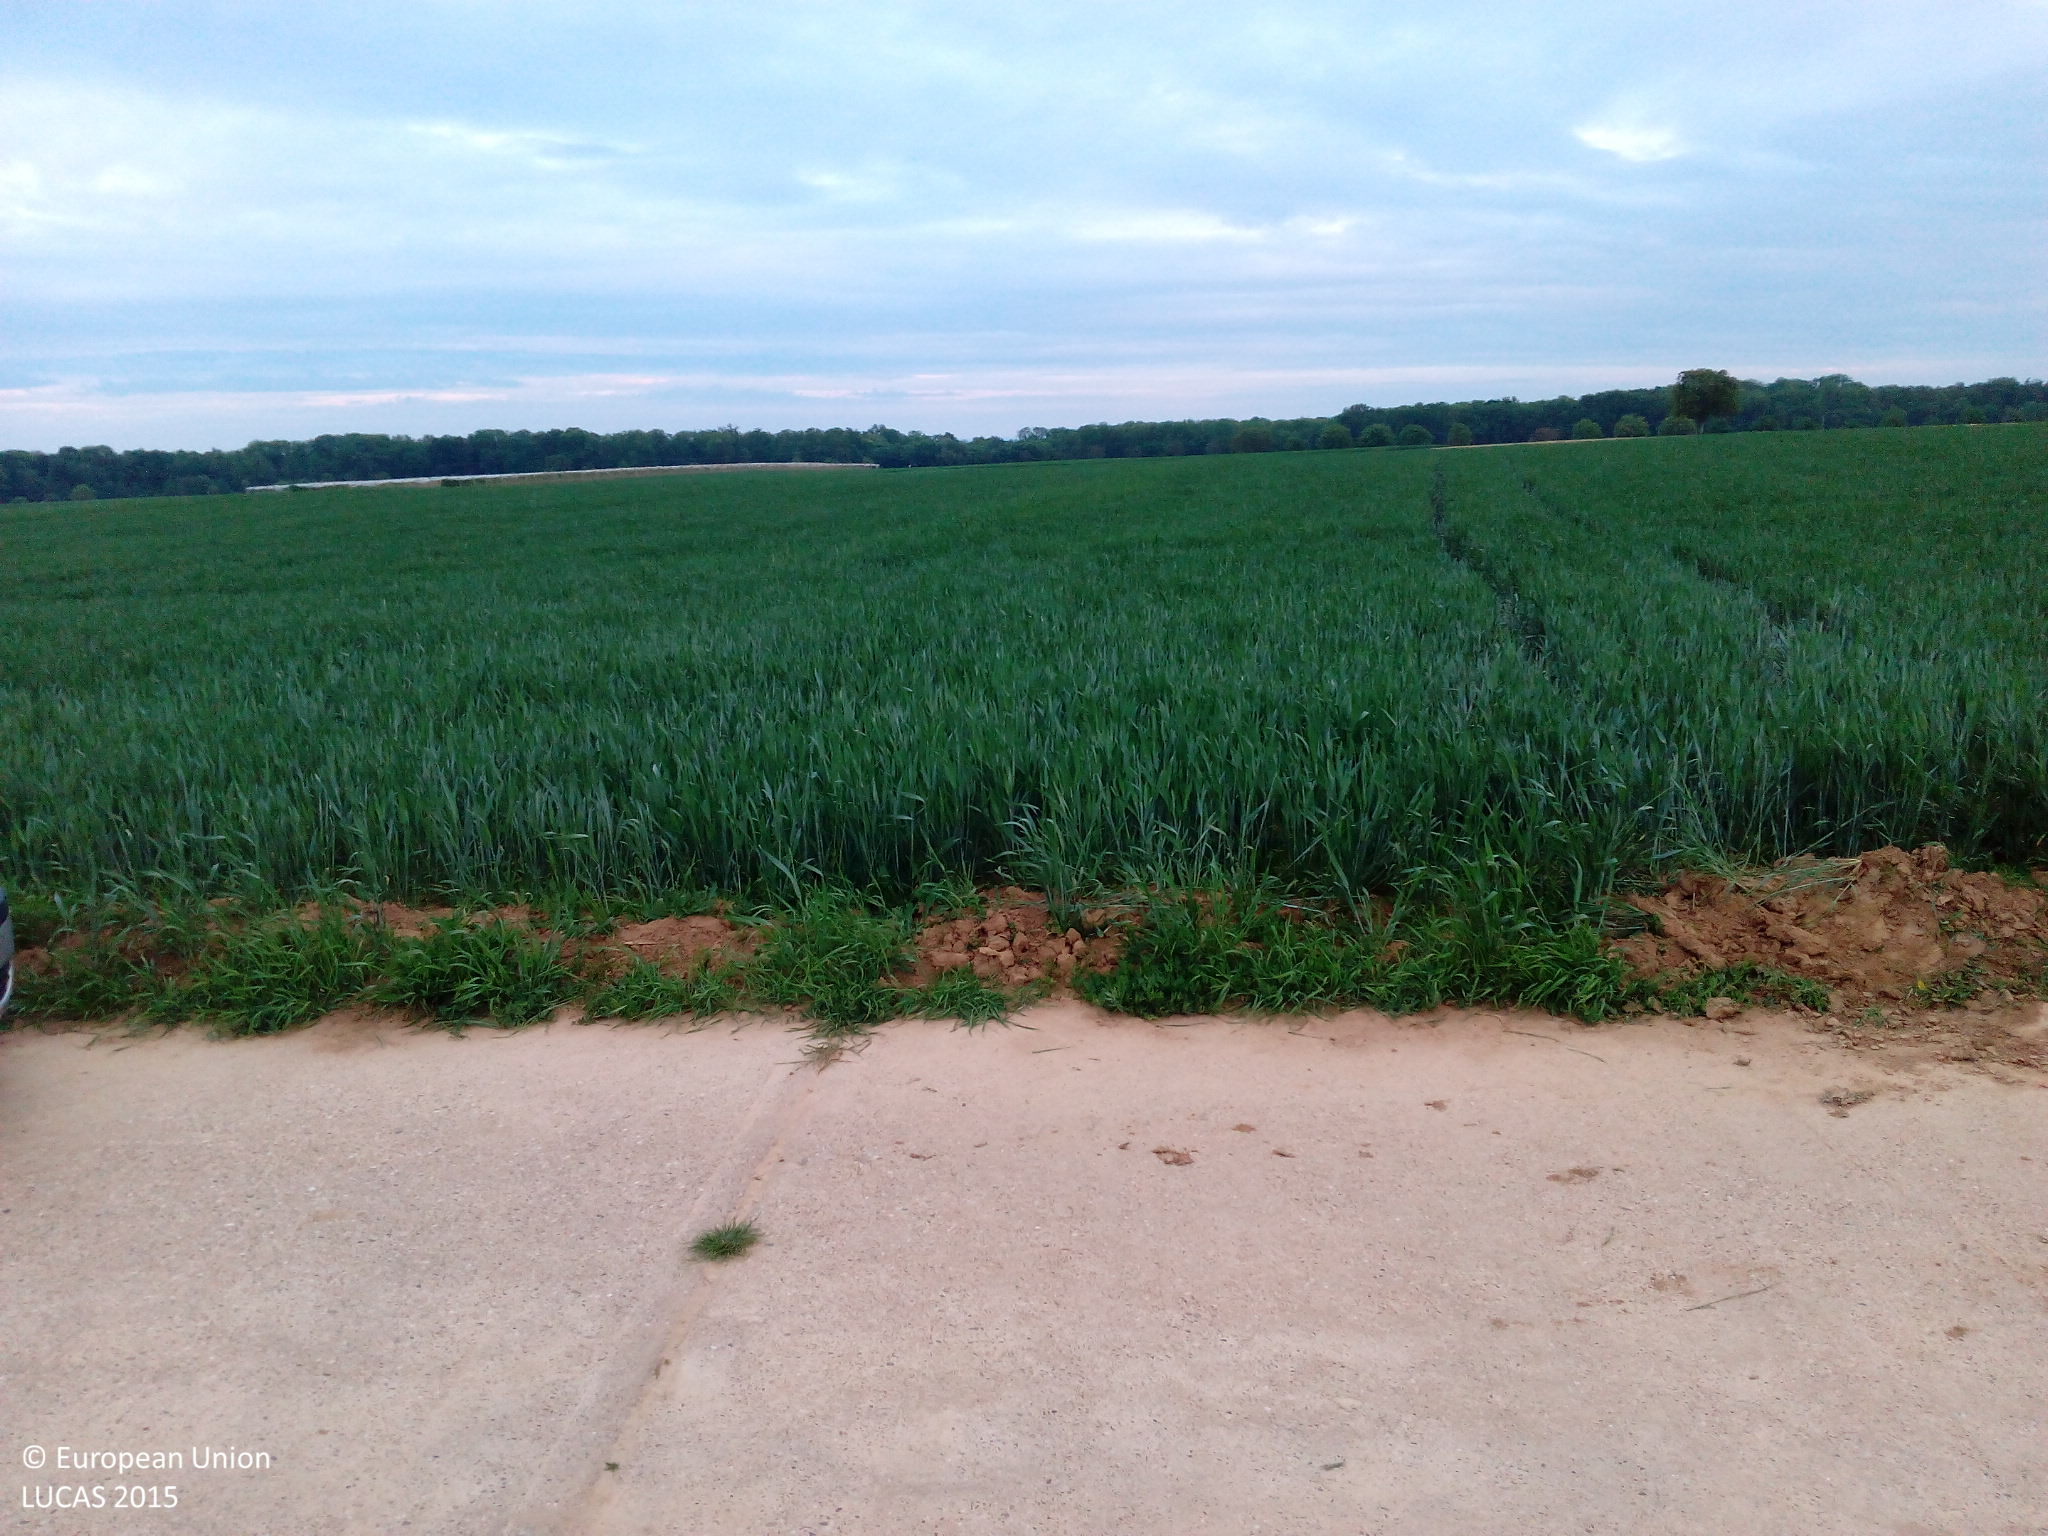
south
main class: Cropland
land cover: Sugar beet
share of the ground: < 10 %
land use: Agriculture (excluding fallow land and kitchen gardens)
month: May
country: DE
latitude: 49.1438
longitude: 8.1499
